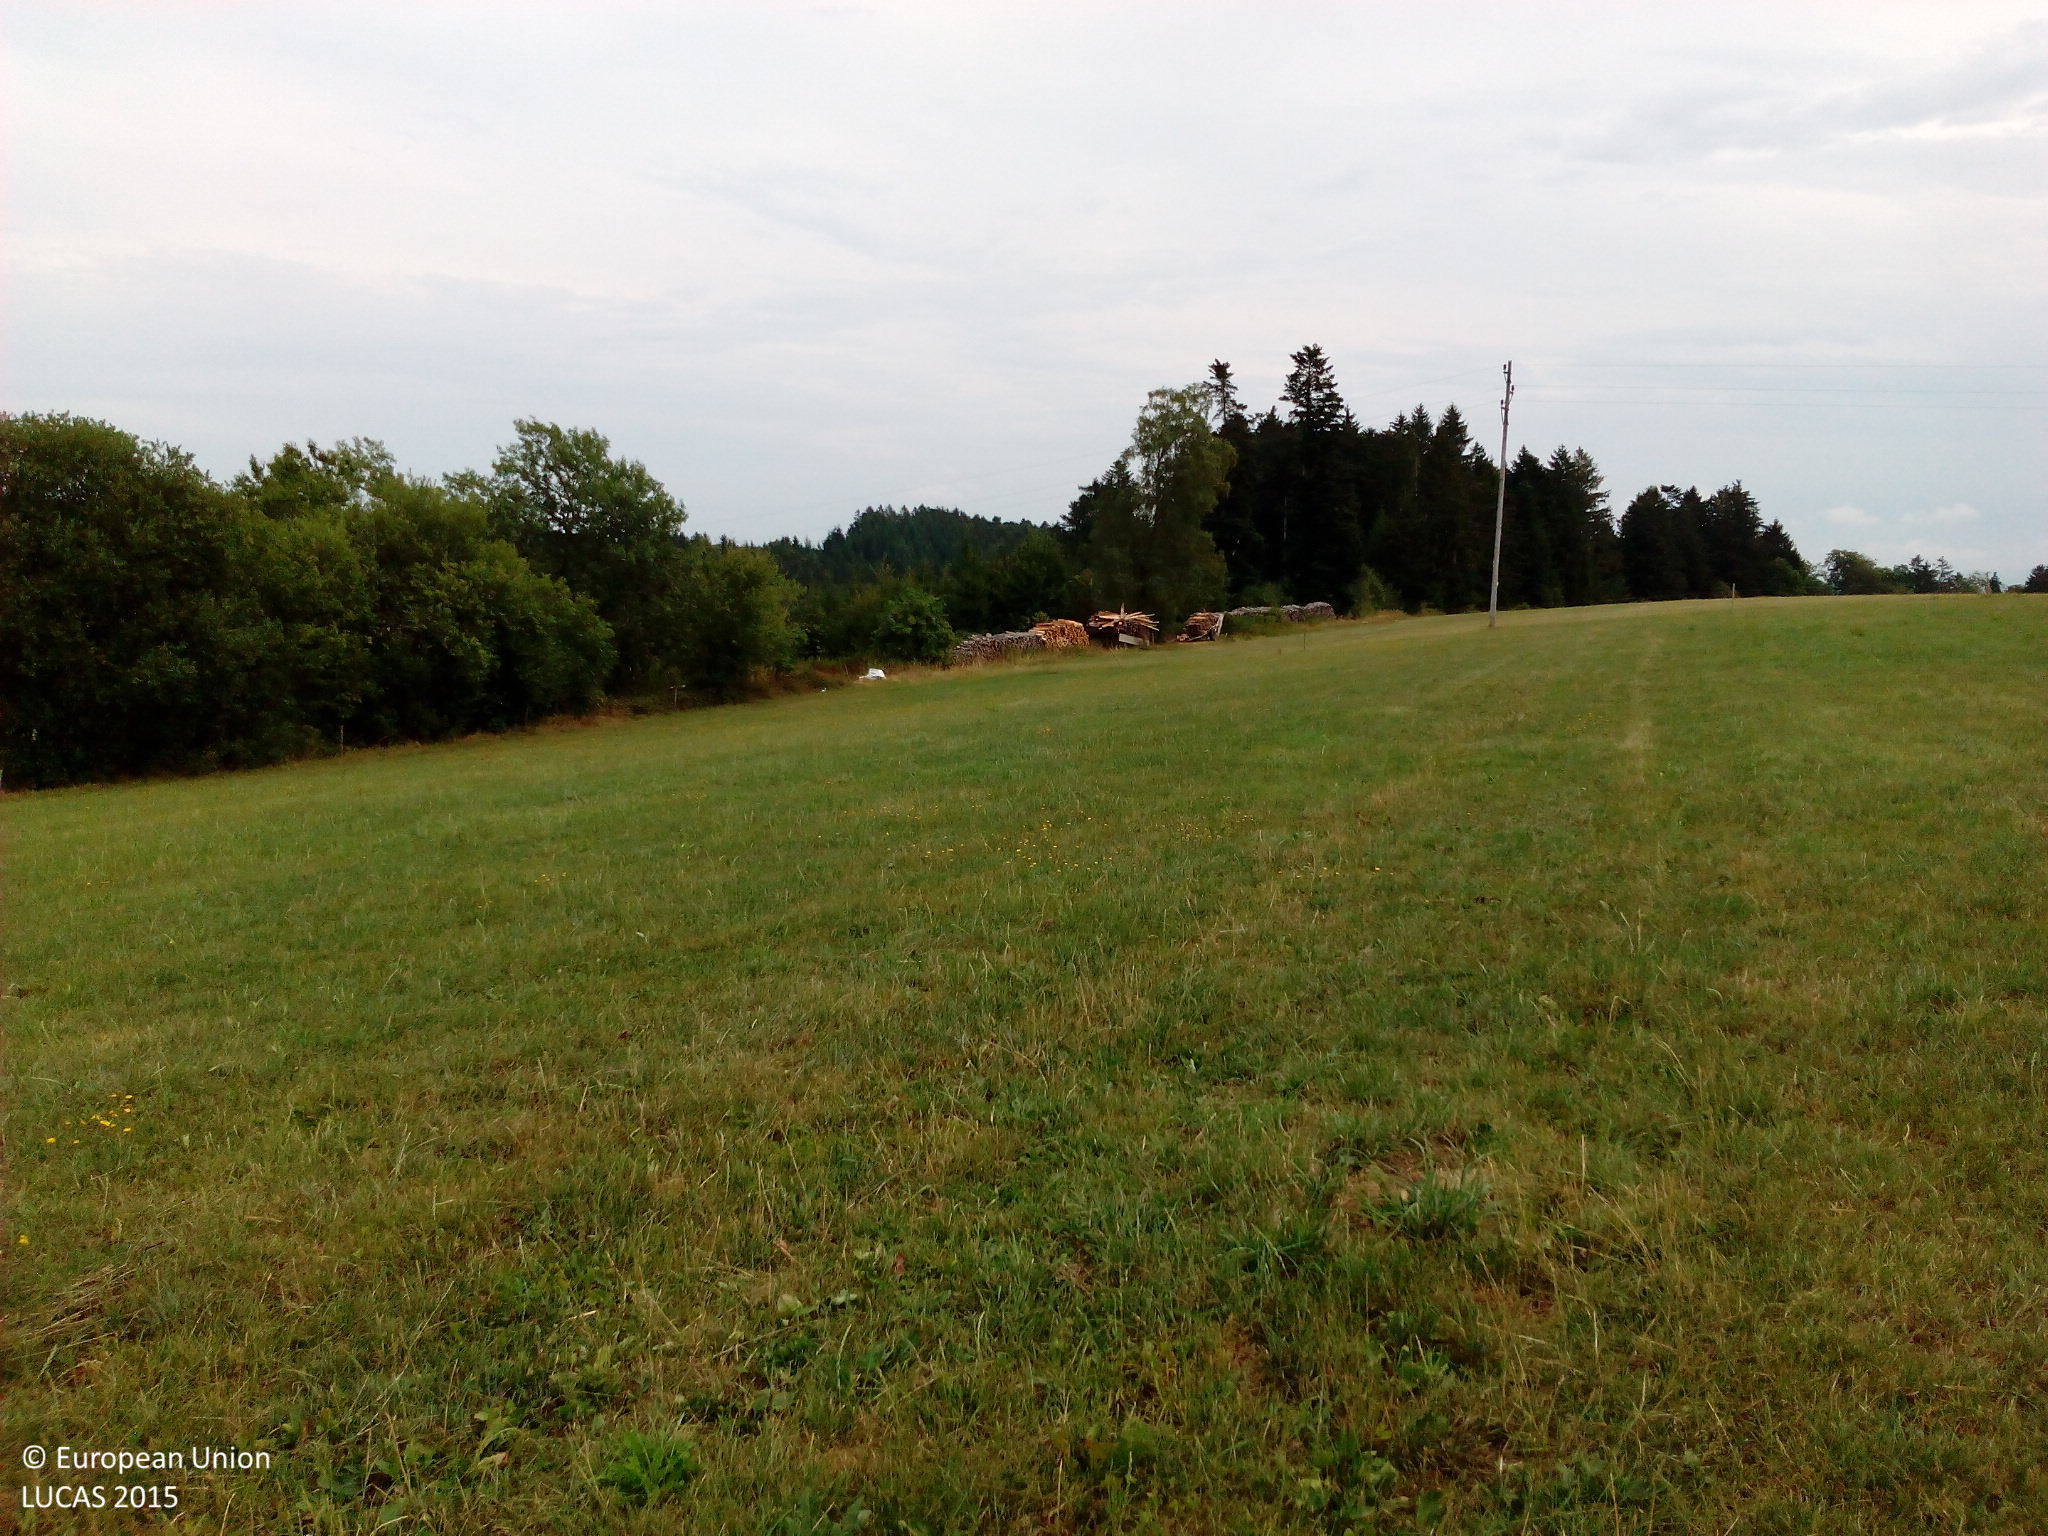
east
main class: Grassland
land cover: Grassland without tree/shrub cover
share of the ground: > 75 %
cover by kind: herbaceous plants 100 %
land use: Agriculture (excluding fallow land and kitchen gardens)
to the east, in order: Grassland without tree/shrub cover; Electric lines; Grassland without tree/shrub cover; Fences; Grassland without tree/shrub cover; Fences; Spontaneously vegetated surfaces; Spruce dominated mixed woodland; Spruce dominated coniferous woodland
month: August
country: DE
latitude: 47.7040
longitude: 8.1489
